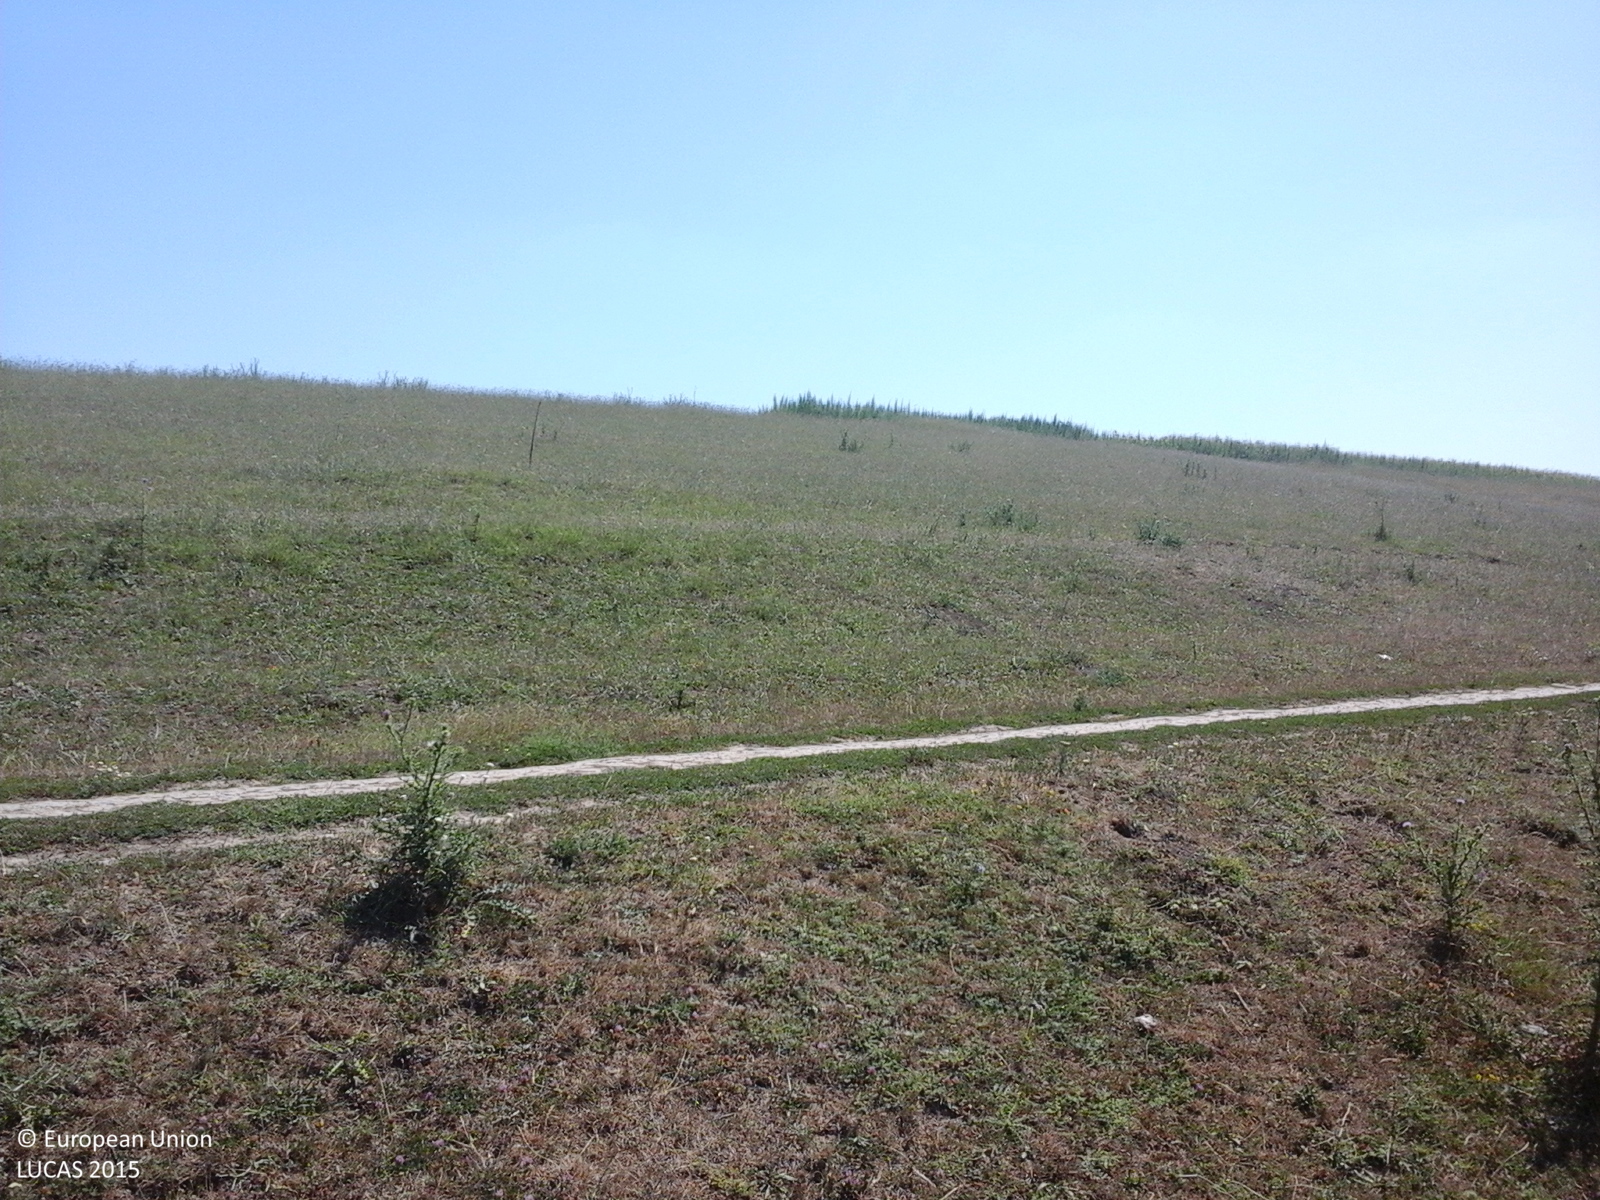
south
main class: Grassland
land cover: Grassland without tree/shrub cover
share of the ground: > 75 %
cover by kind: herbaceous plants 100 %
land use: Agriculture (excluding fallow land and kitchen gardens)
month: July
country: RO
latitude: 44.3853
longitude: 26.5725
